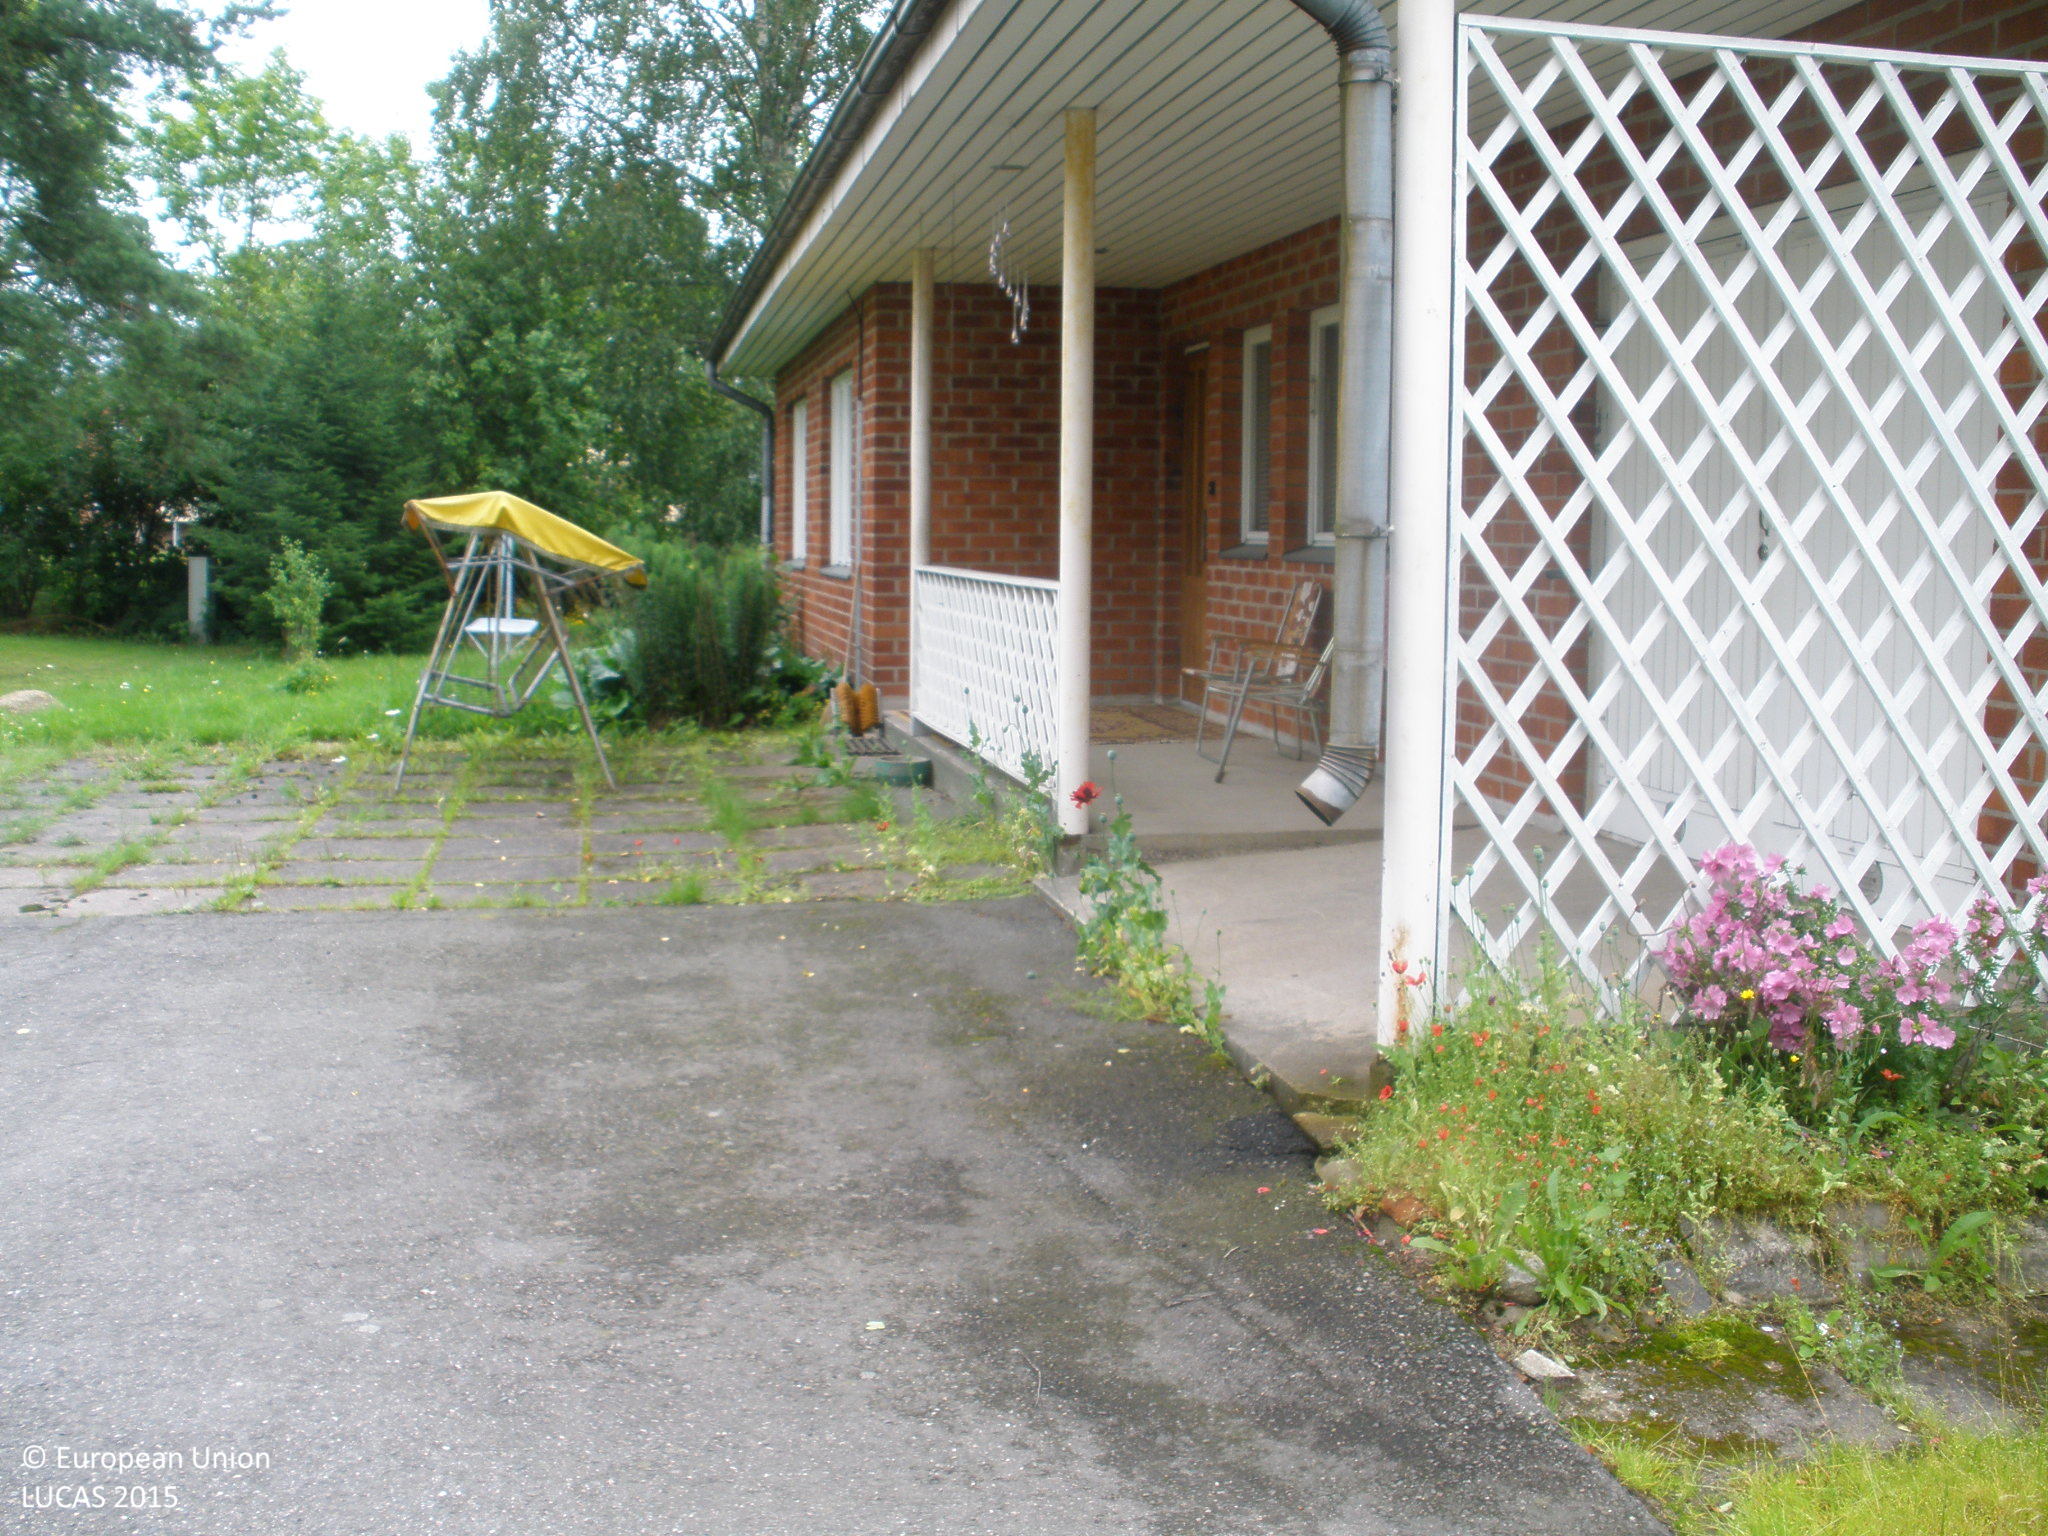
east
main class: Grassland
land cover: Grassland with sparse tree/shrub cover
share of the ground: > 75 %
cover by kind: herbaceous plants 95 %, broadleaved forest trees 5 %
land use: Residential
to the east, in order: Grassland with sparse tree/shrub cover; Artificial constructions in urban areas
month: July
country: FI
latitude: 60.6243
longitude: 23.5187
